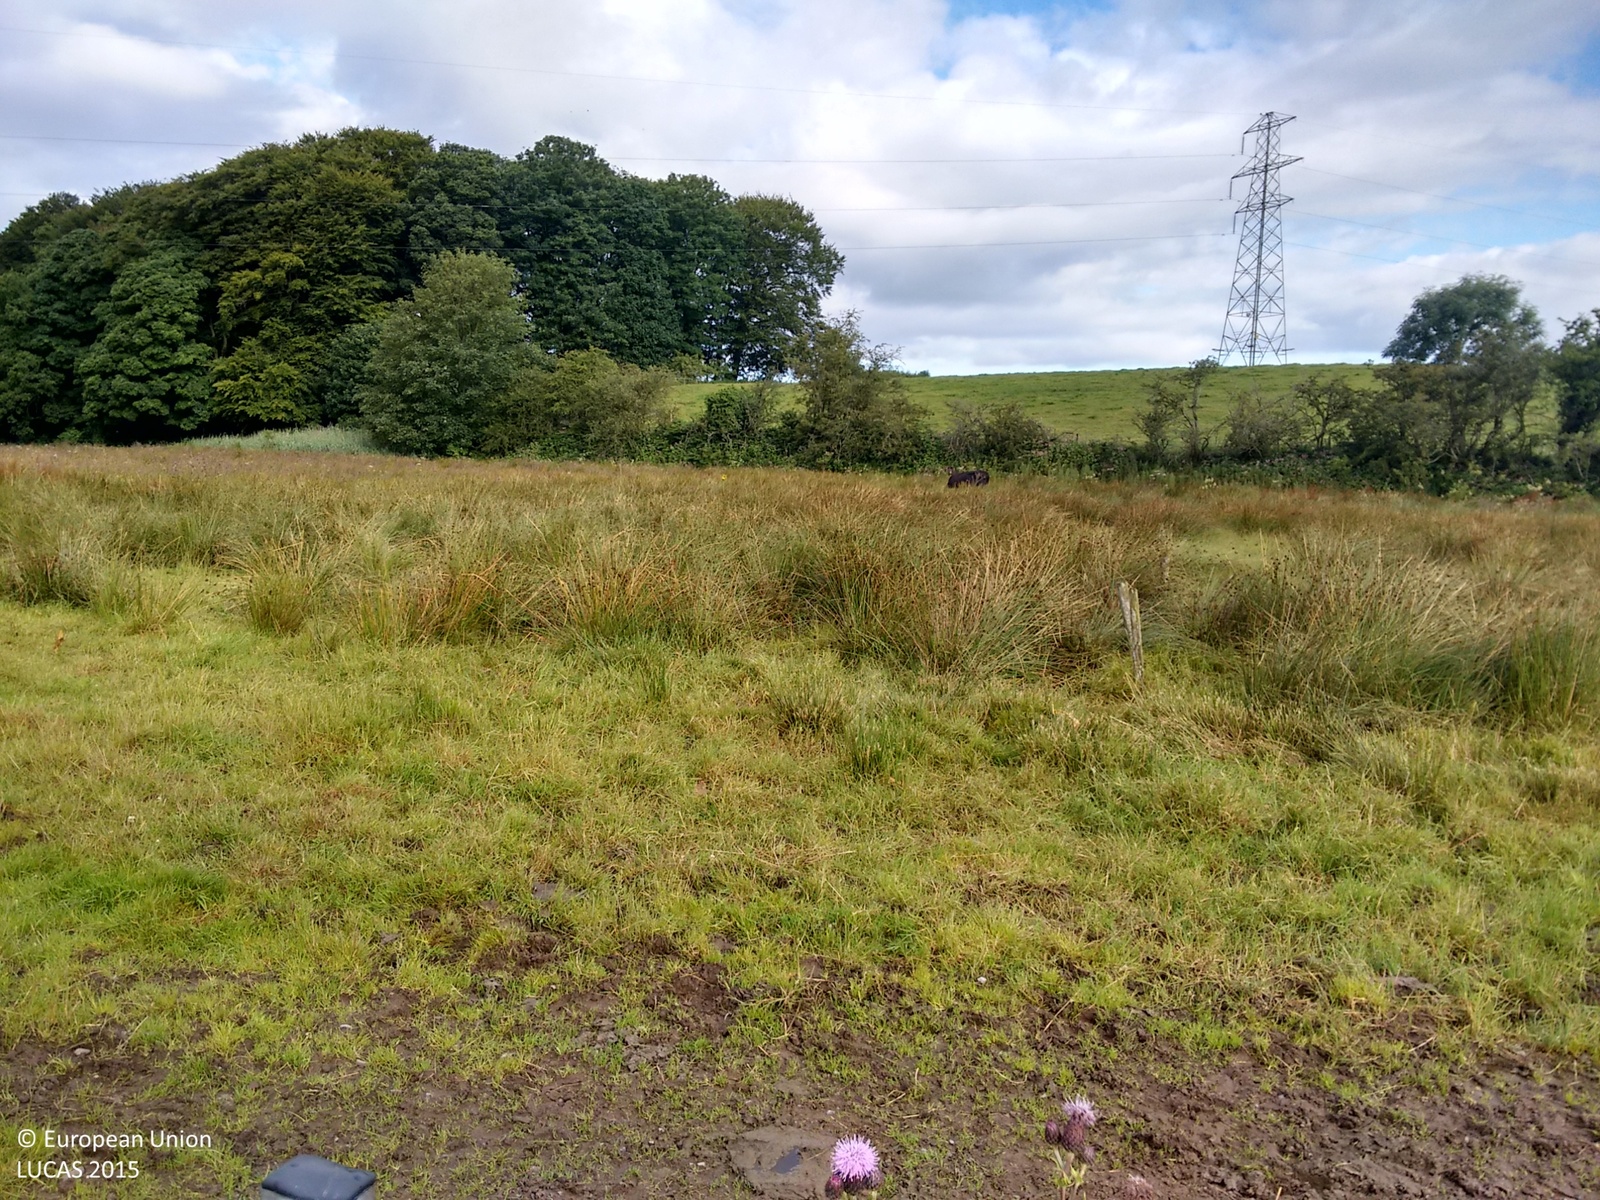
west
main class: Grassland
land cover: Grassland without tree/shrub cover
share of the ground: > 75 %
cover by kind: herbaceous plants 100 %
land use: Agriculture (excluding fallow land and kitchen gardens)
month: July
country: GB
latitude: 55.0327
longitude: -2.9784
